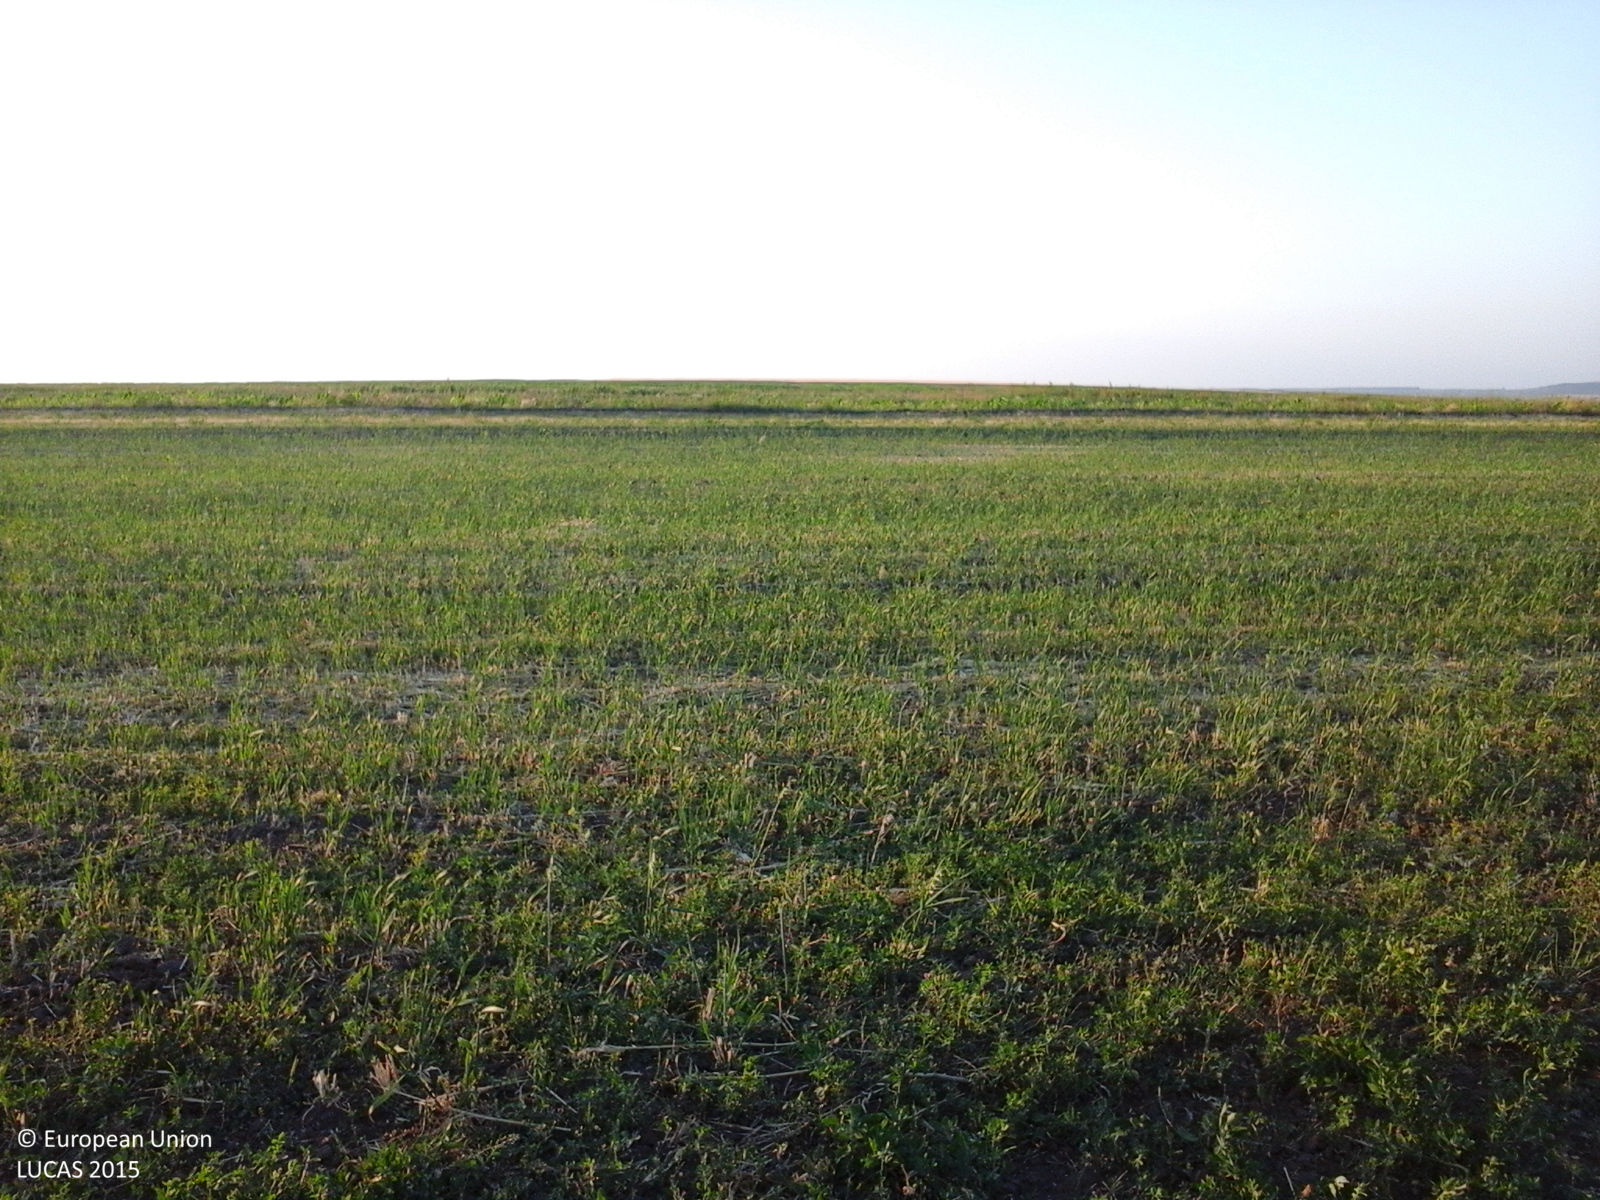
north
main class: Cropland
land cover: Lucerne
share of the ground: > 75 %
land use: Agriculture (excluding fallow land and kitchen gardens)
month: June
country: RO
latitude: 47.1343
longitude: 27.4241
